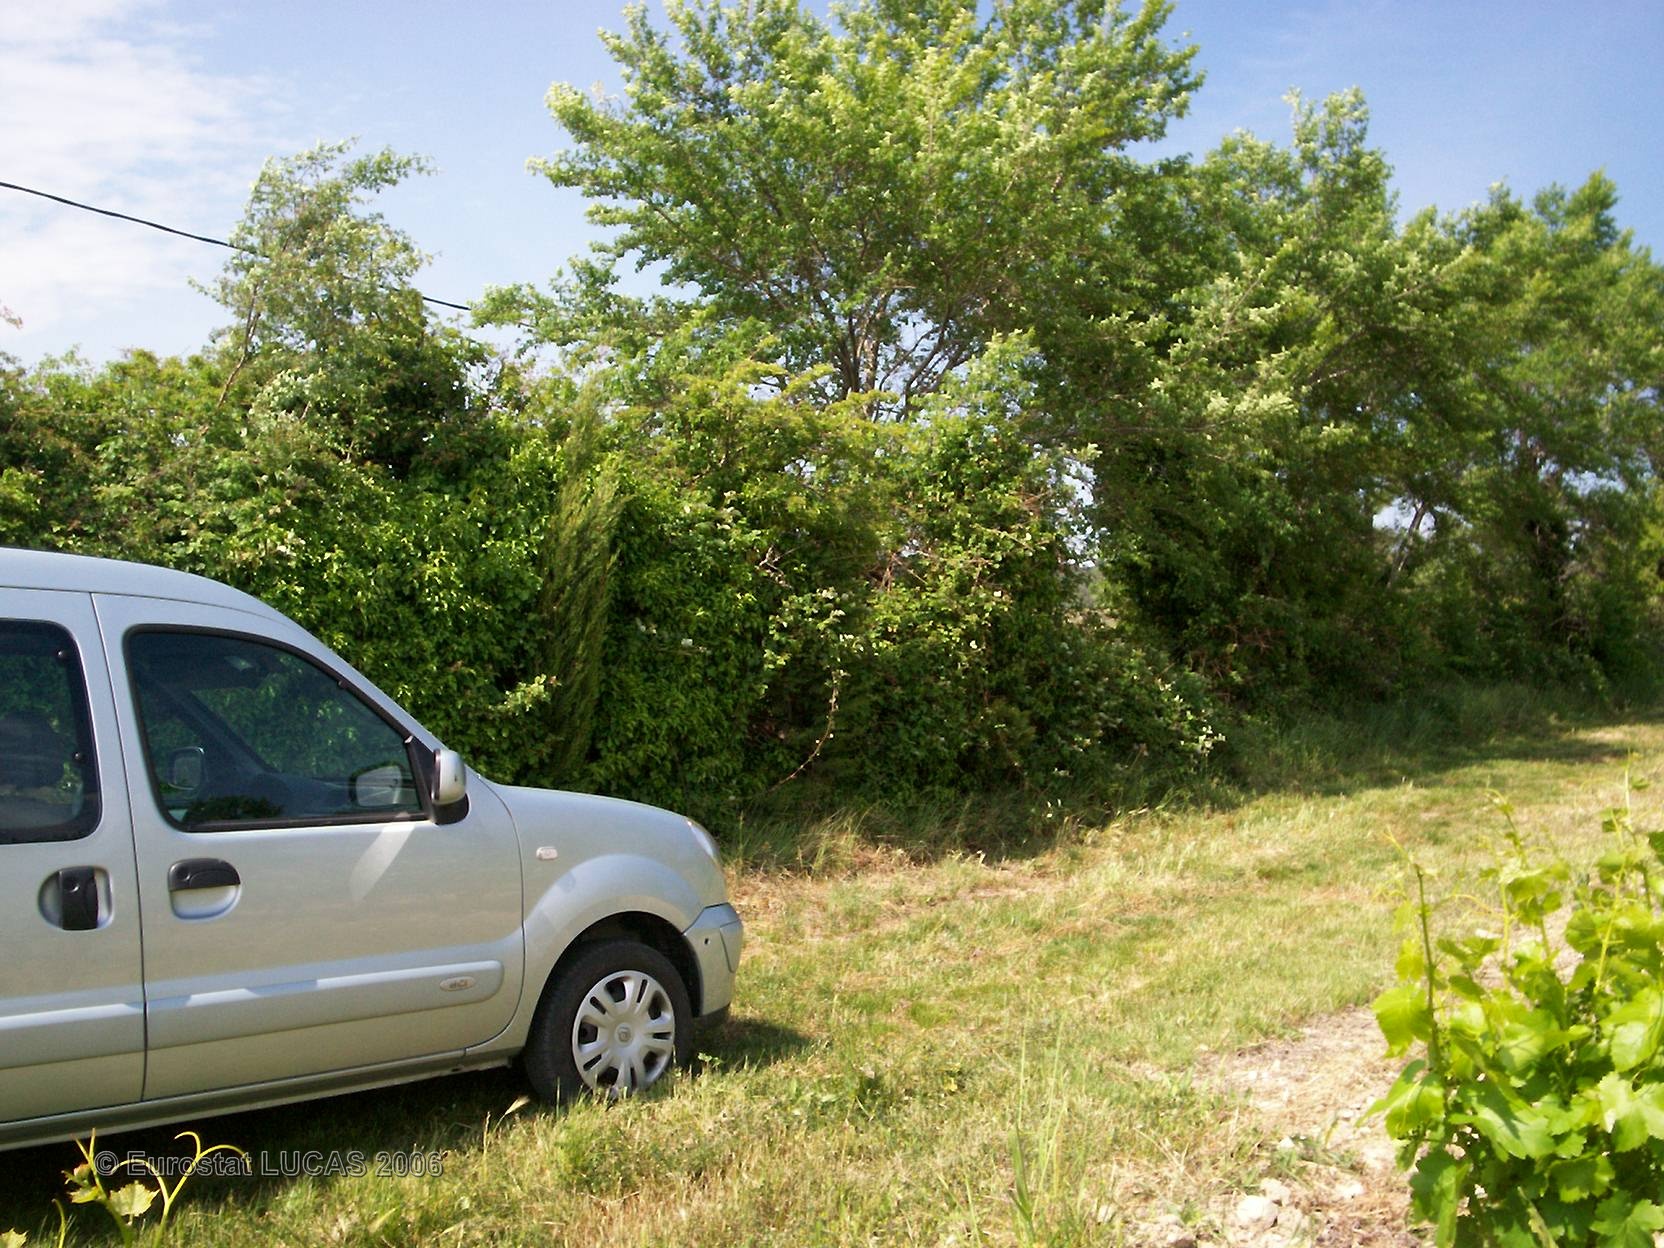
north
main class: Cropland
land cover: Vineyards
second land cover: Grassland with sparse tree/shrub cover
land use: Agriculture (excluding fallow land and kitchen gardens)
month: May
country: FR
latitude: 44.3182
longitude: 4.9546
